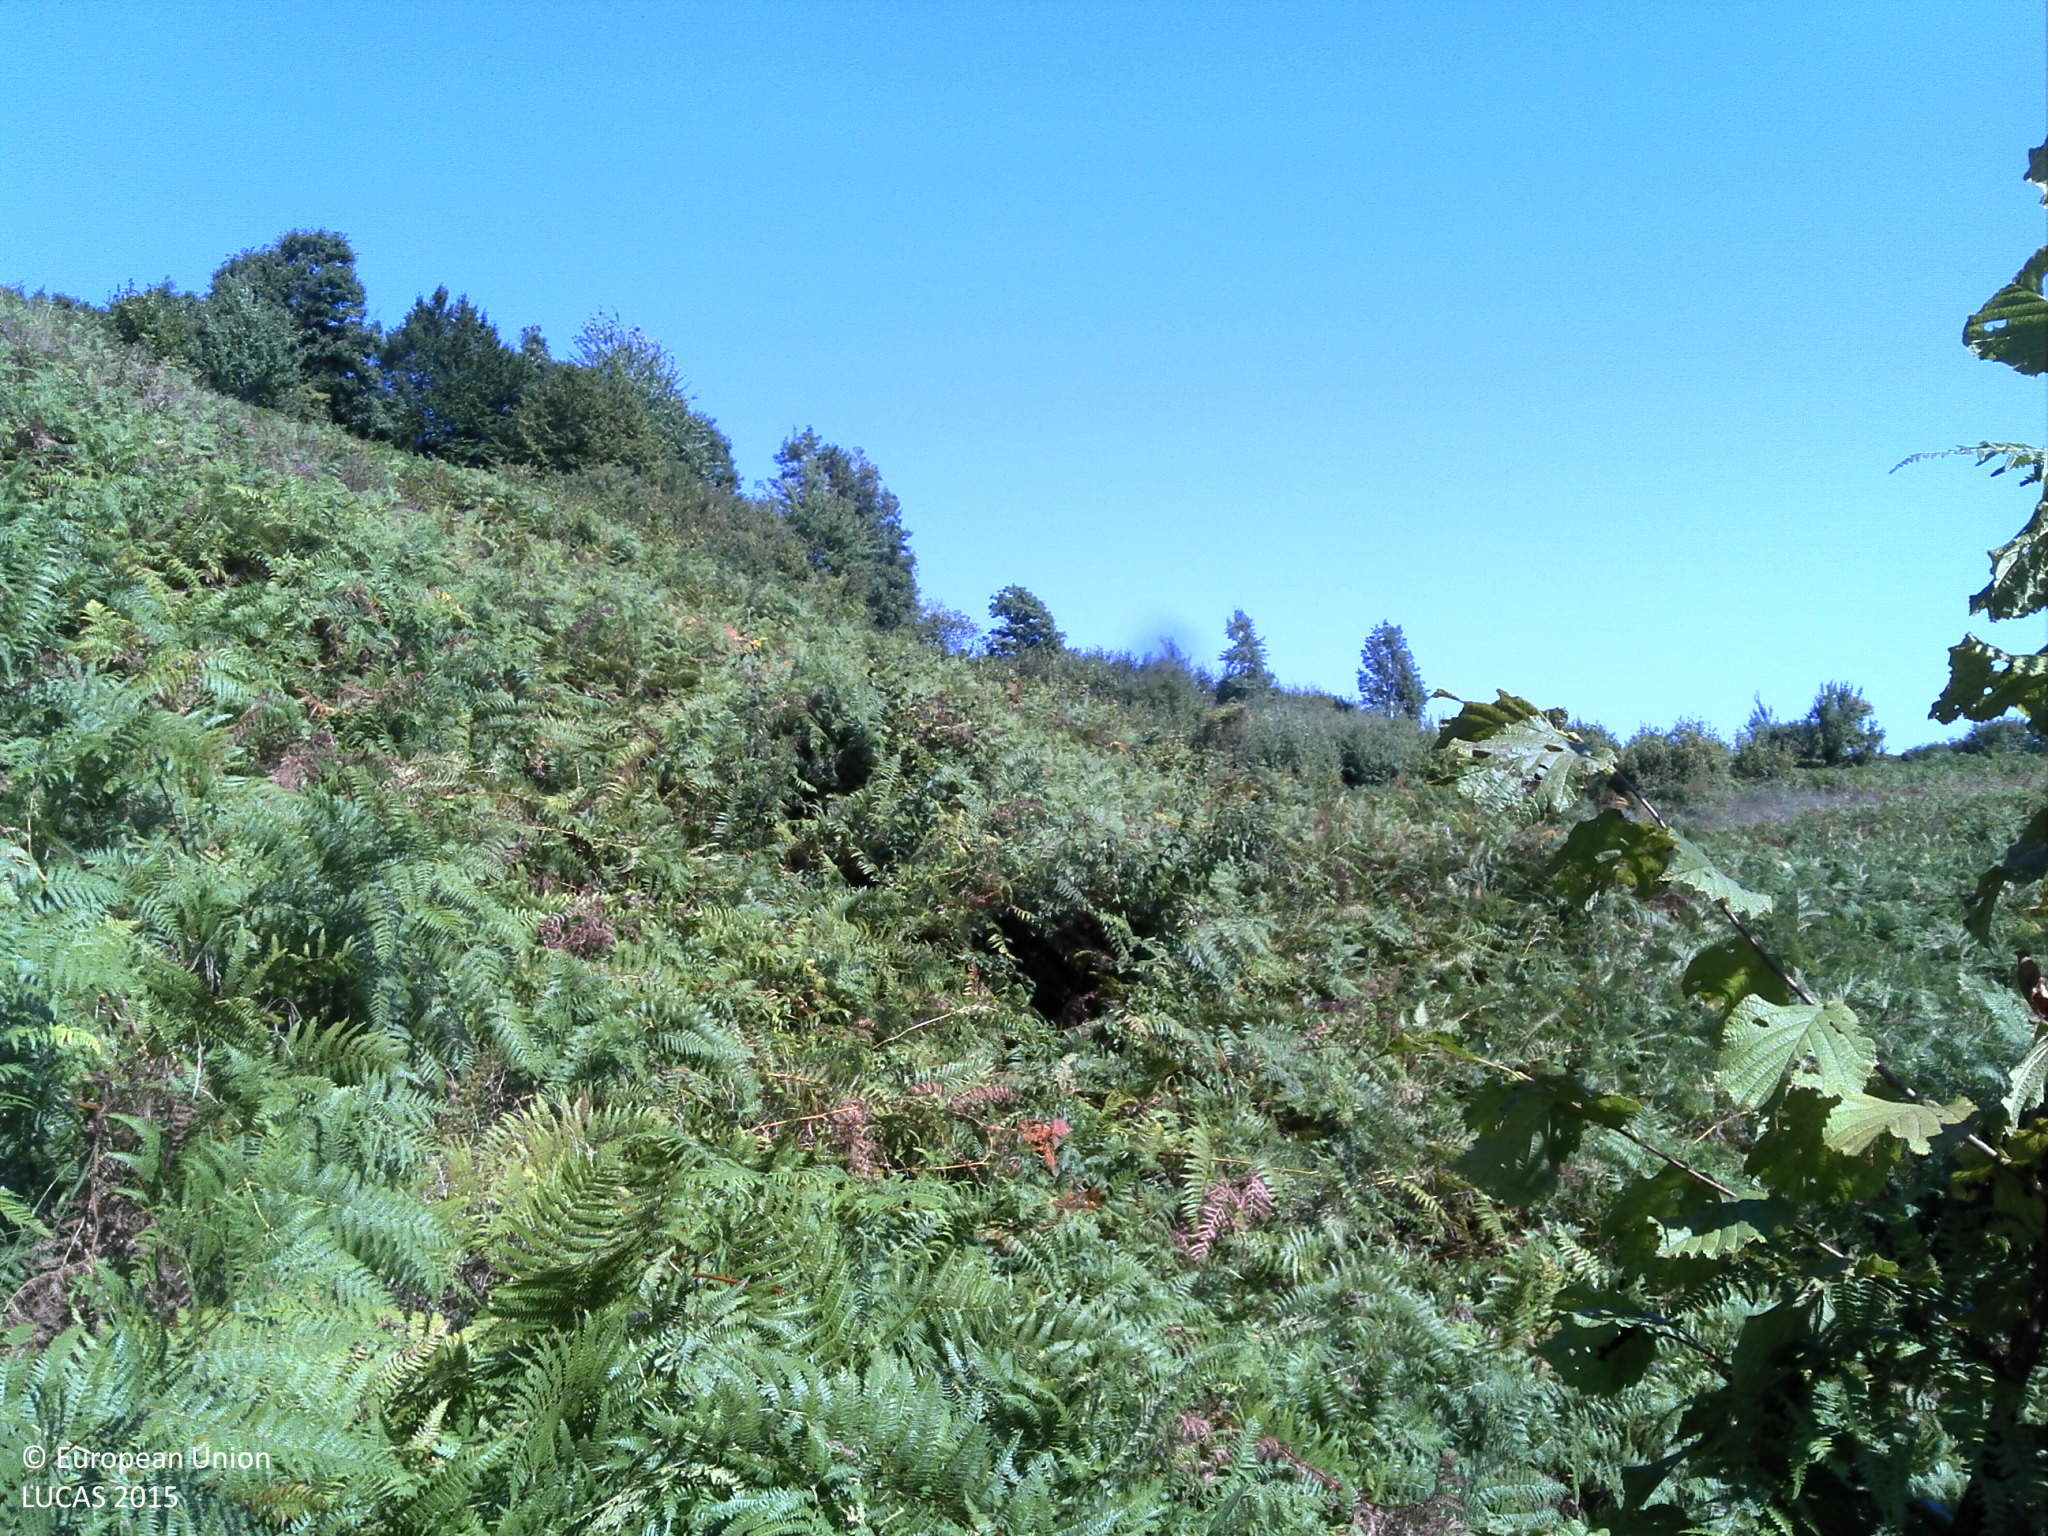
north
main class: Shrubland
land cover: Shrubland without tree cover
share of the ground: > 75 %
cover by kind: shrubs 100 %
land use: Semi-natural and natural areas not in use
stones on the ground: < 10 %
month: September
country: HR
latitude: 44.9564
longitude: 15.6358
